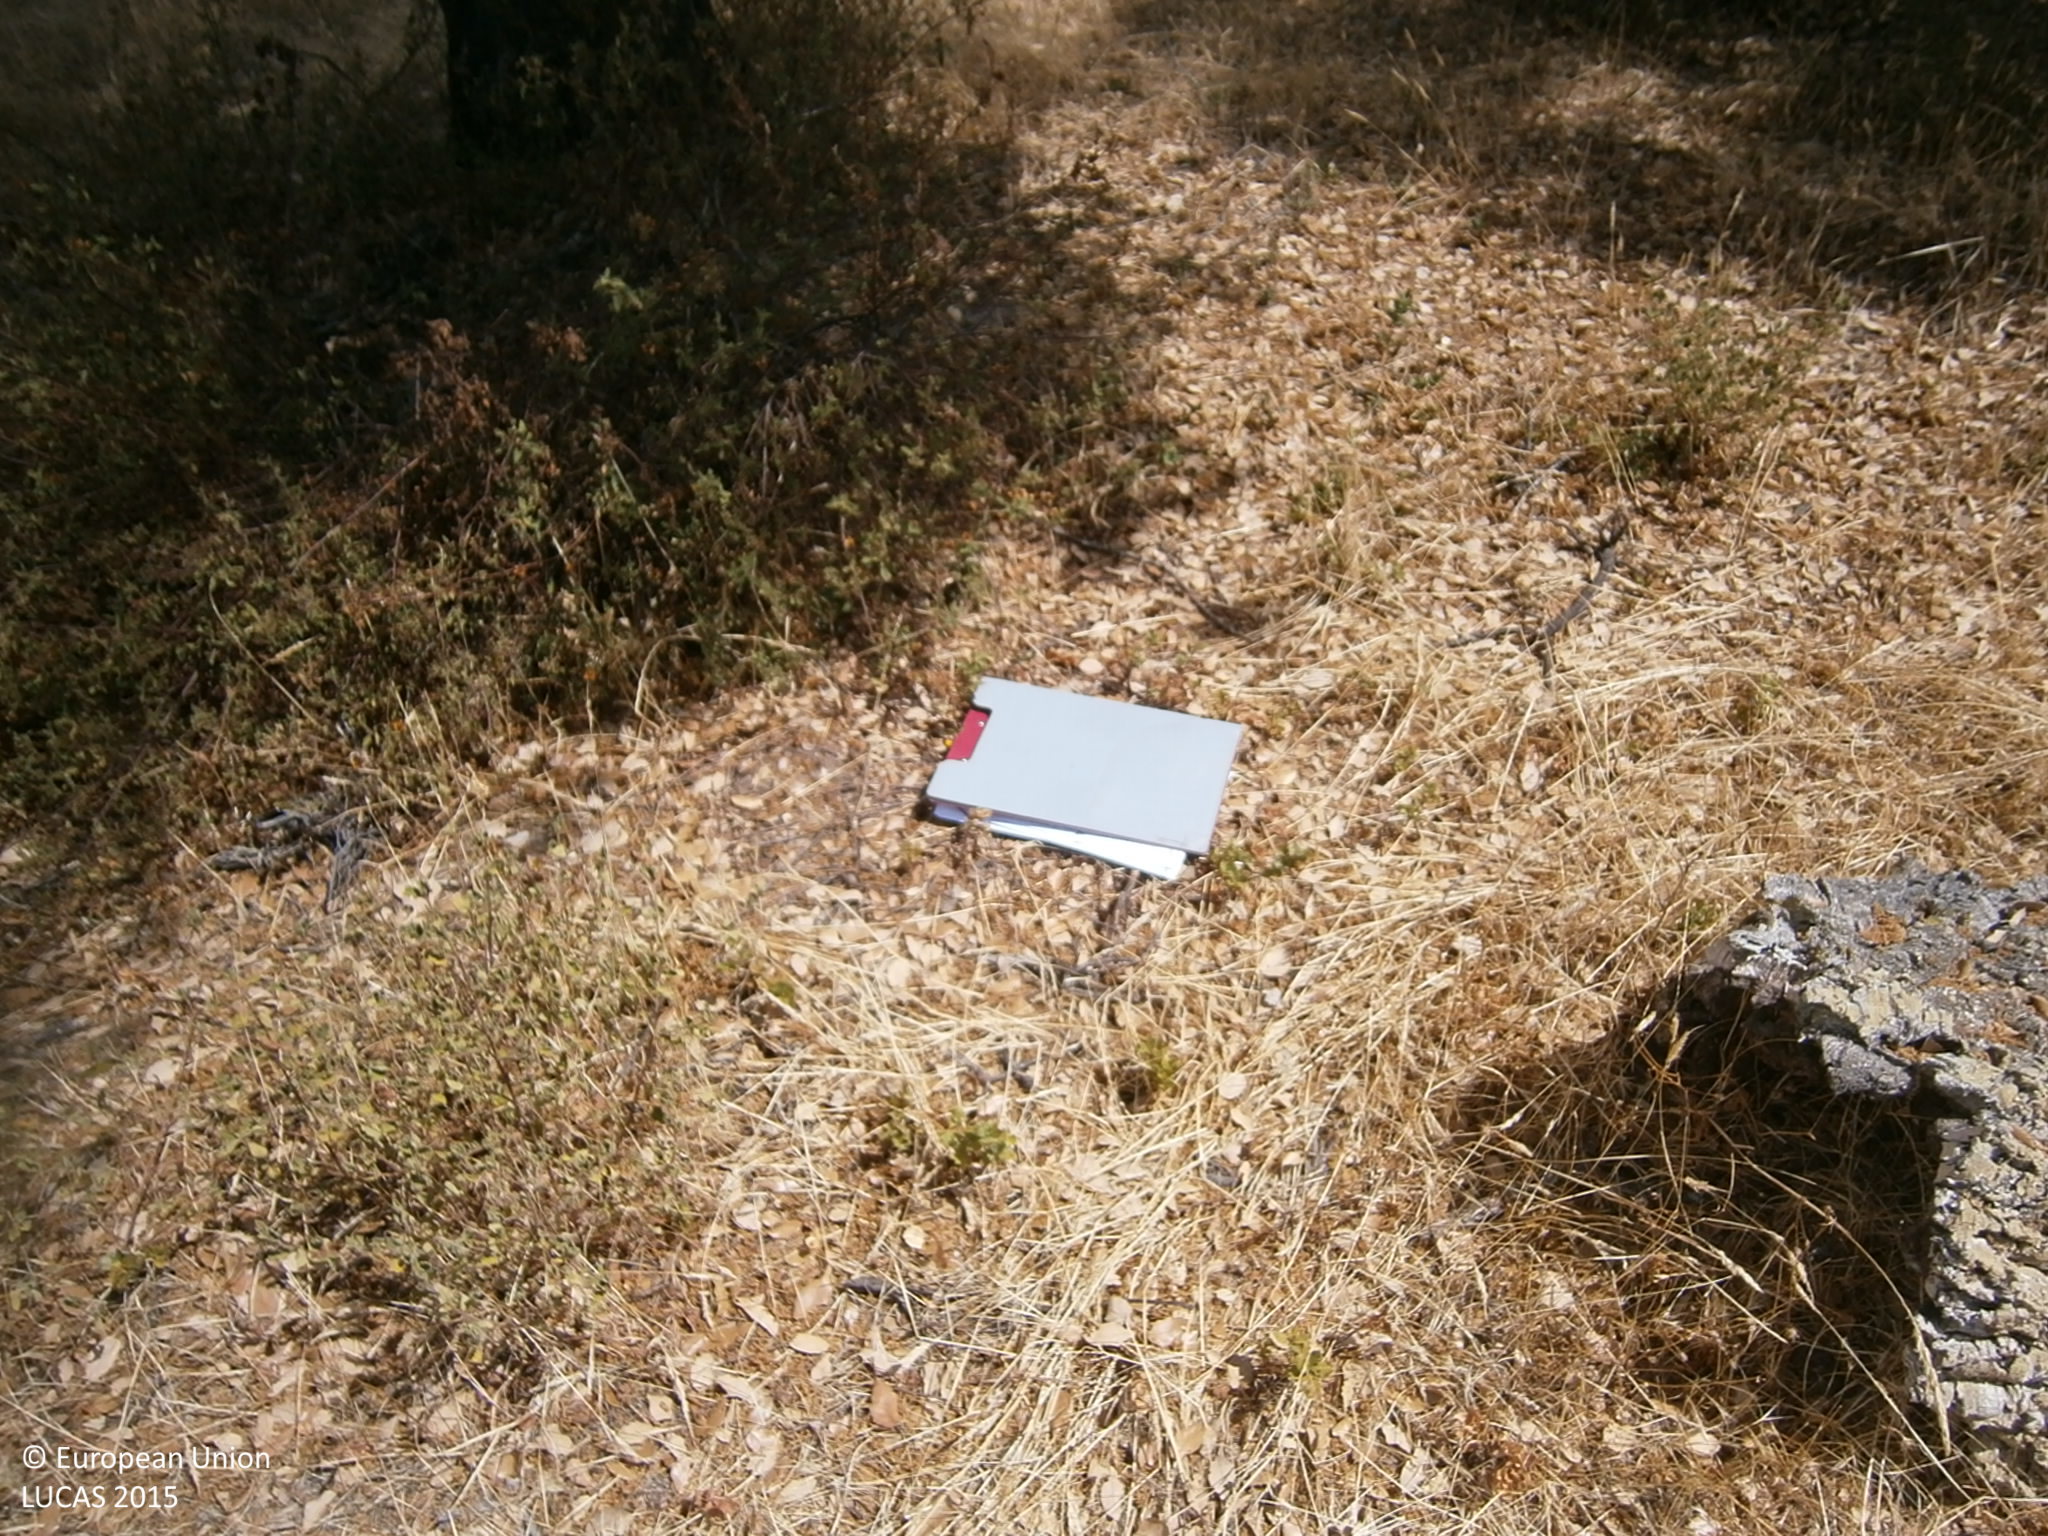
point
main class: Woodland
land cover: Broadleaved woodland
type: broadleaved evergreen forest
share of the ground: > 75 %
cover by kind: herbaceous plants 60 %, broadleaved forest trees 30 %, shrubs 10 %
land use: Forestry
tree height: > 5 m
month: July
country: ES
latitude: 38.7931
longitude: -6.9814
